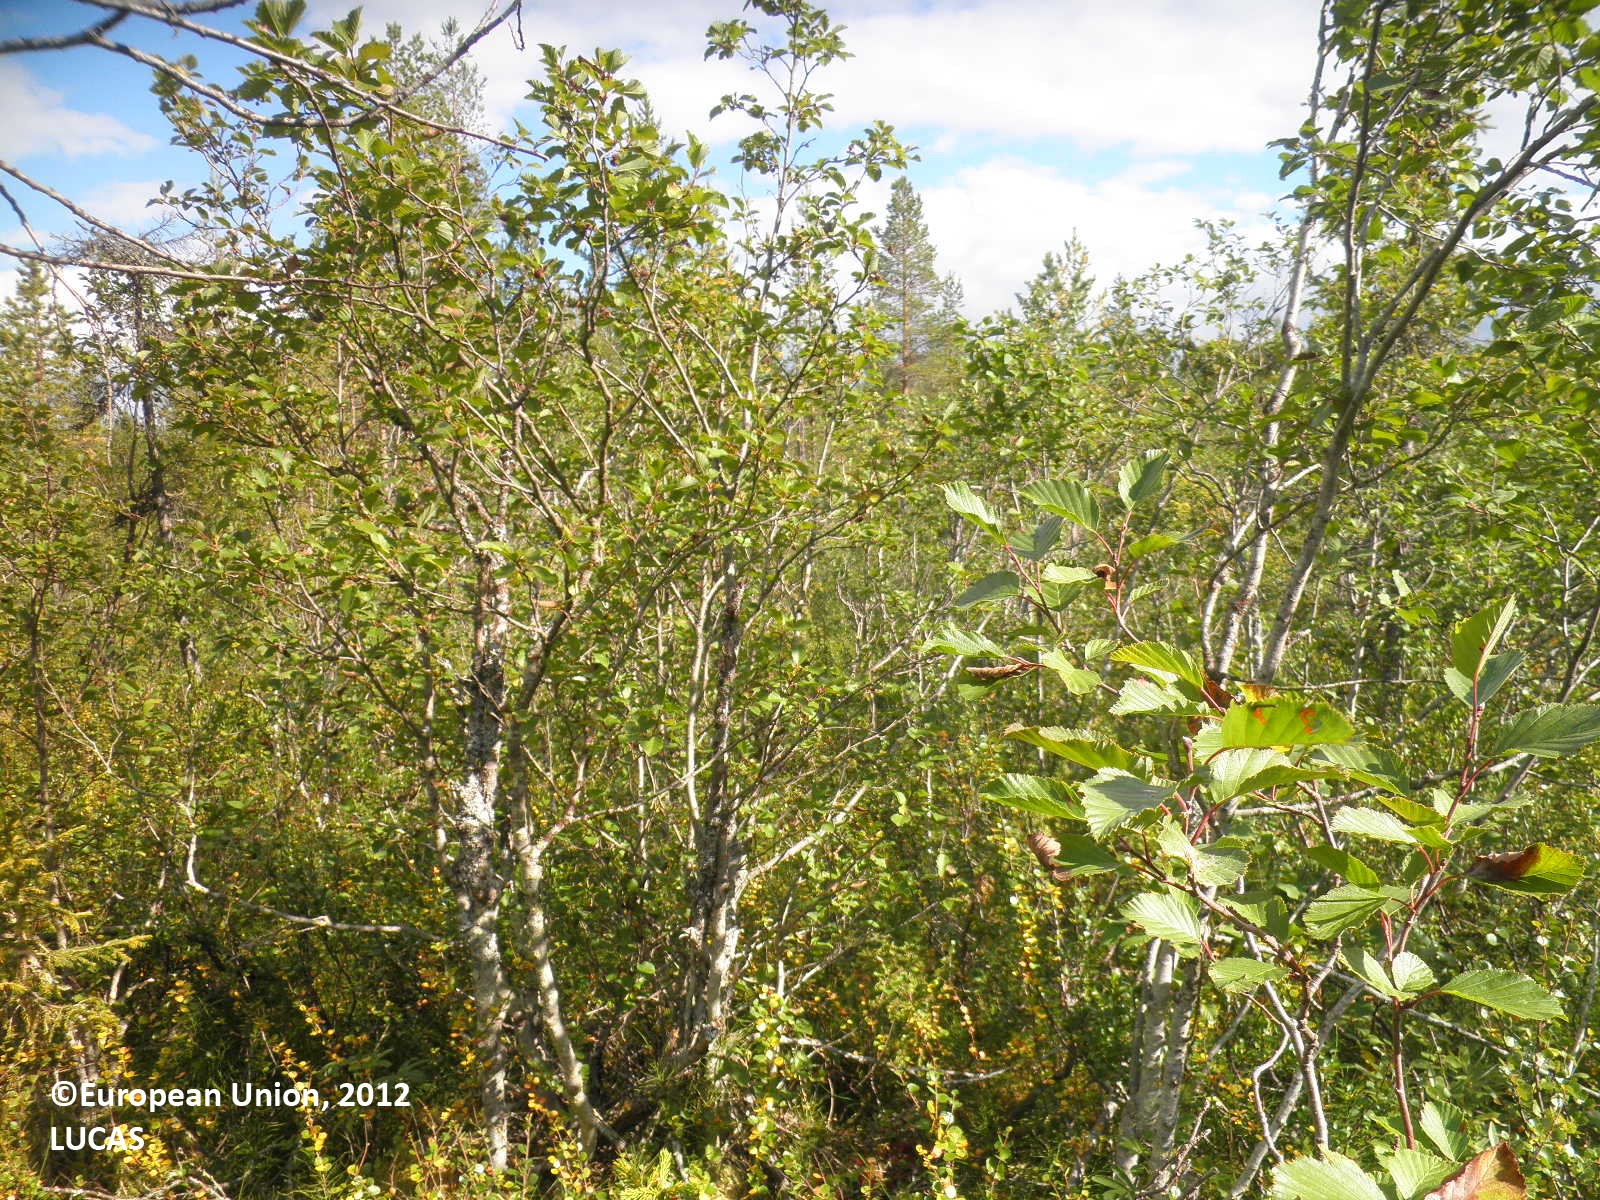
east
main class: Woodland
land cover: Spruce dominated mixed woodland
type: boreal forest
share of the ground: 50 - 75 %
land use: Forestry
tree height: > 5 m
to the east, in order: Spruce dominated mixed woodland; Pine dominated mixed woodland; Peatbogs; Pine dominated coniferous woodland; Pine dominated mixed woodland; Pine dominated coniferous woodland
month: August
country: FI
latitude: 67.5549
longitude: 26.1394
